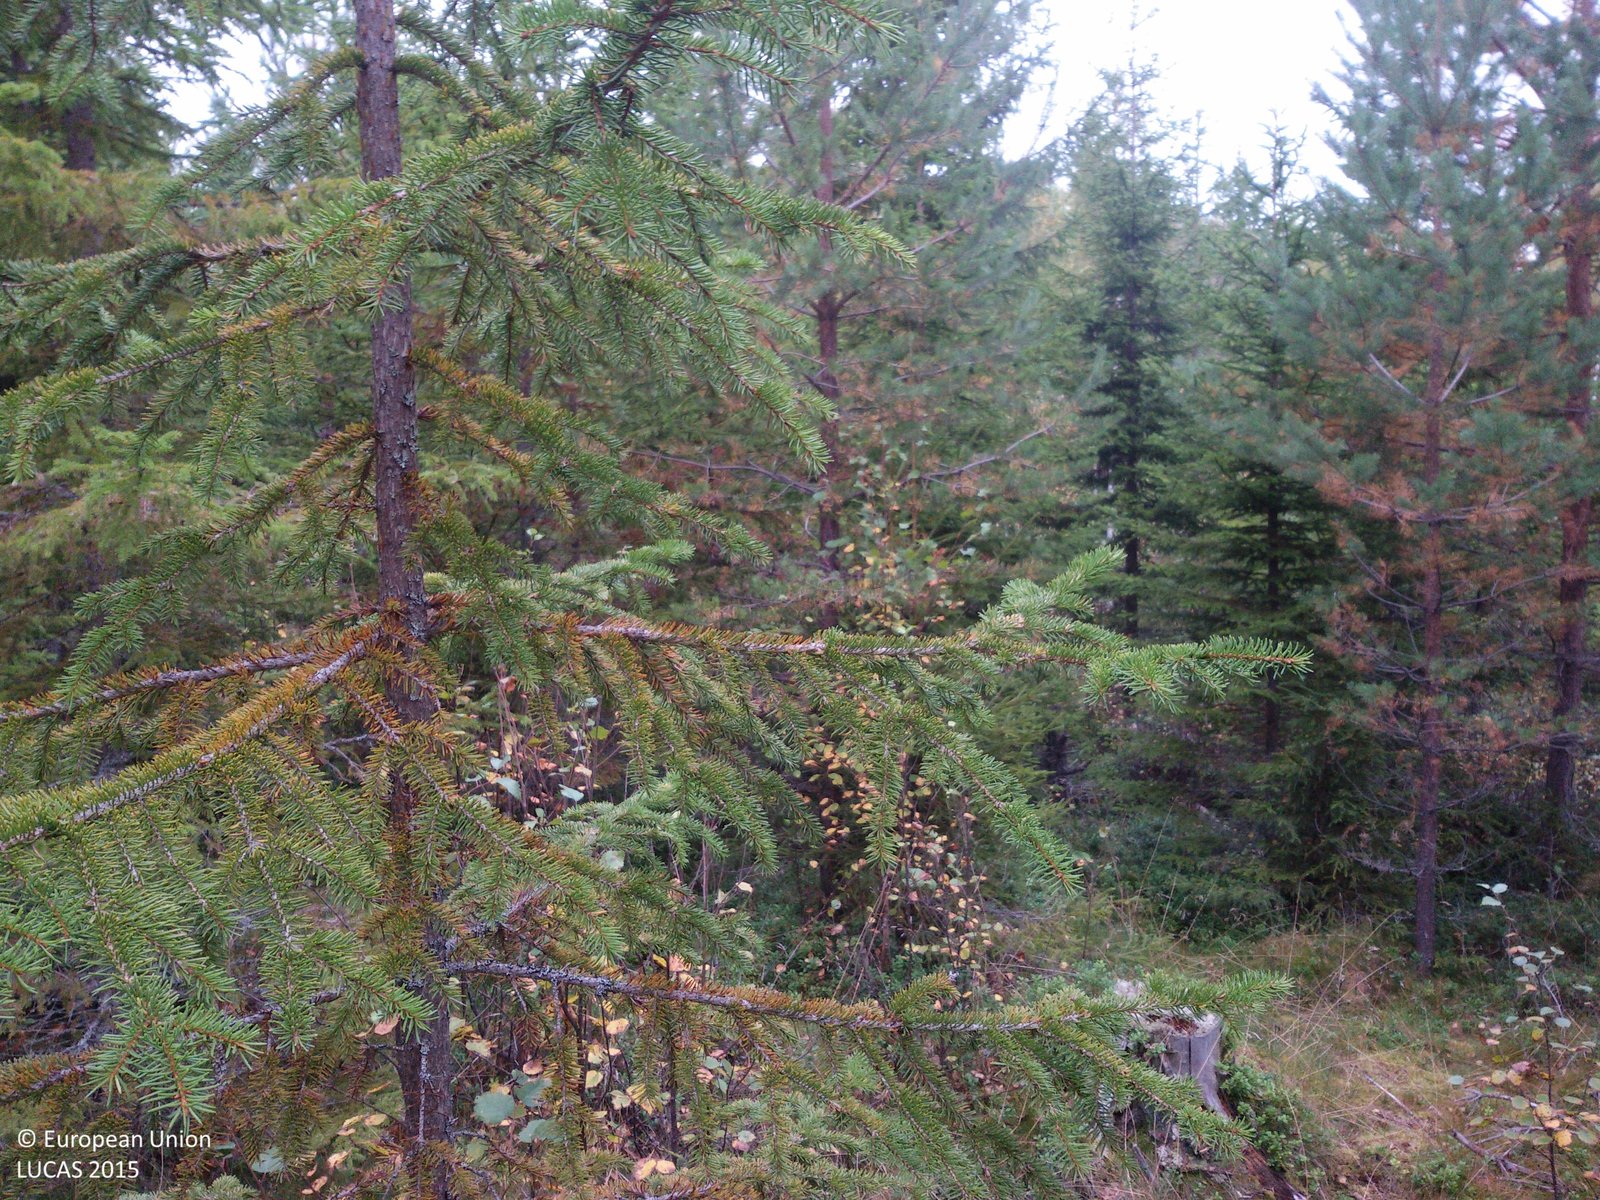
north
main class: Woodland
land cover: Spruce dominated coniferous woodland
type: boreal forest
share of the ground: 50 - 75 %
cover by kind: coniferous forest trees 70 %, lichens and mosses 15 %, shrubs 10 %, herbaceous plants 5 %
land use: Forestry
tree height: > 5 m
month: September
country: SE
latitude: 60.6880
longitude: 14.9863
